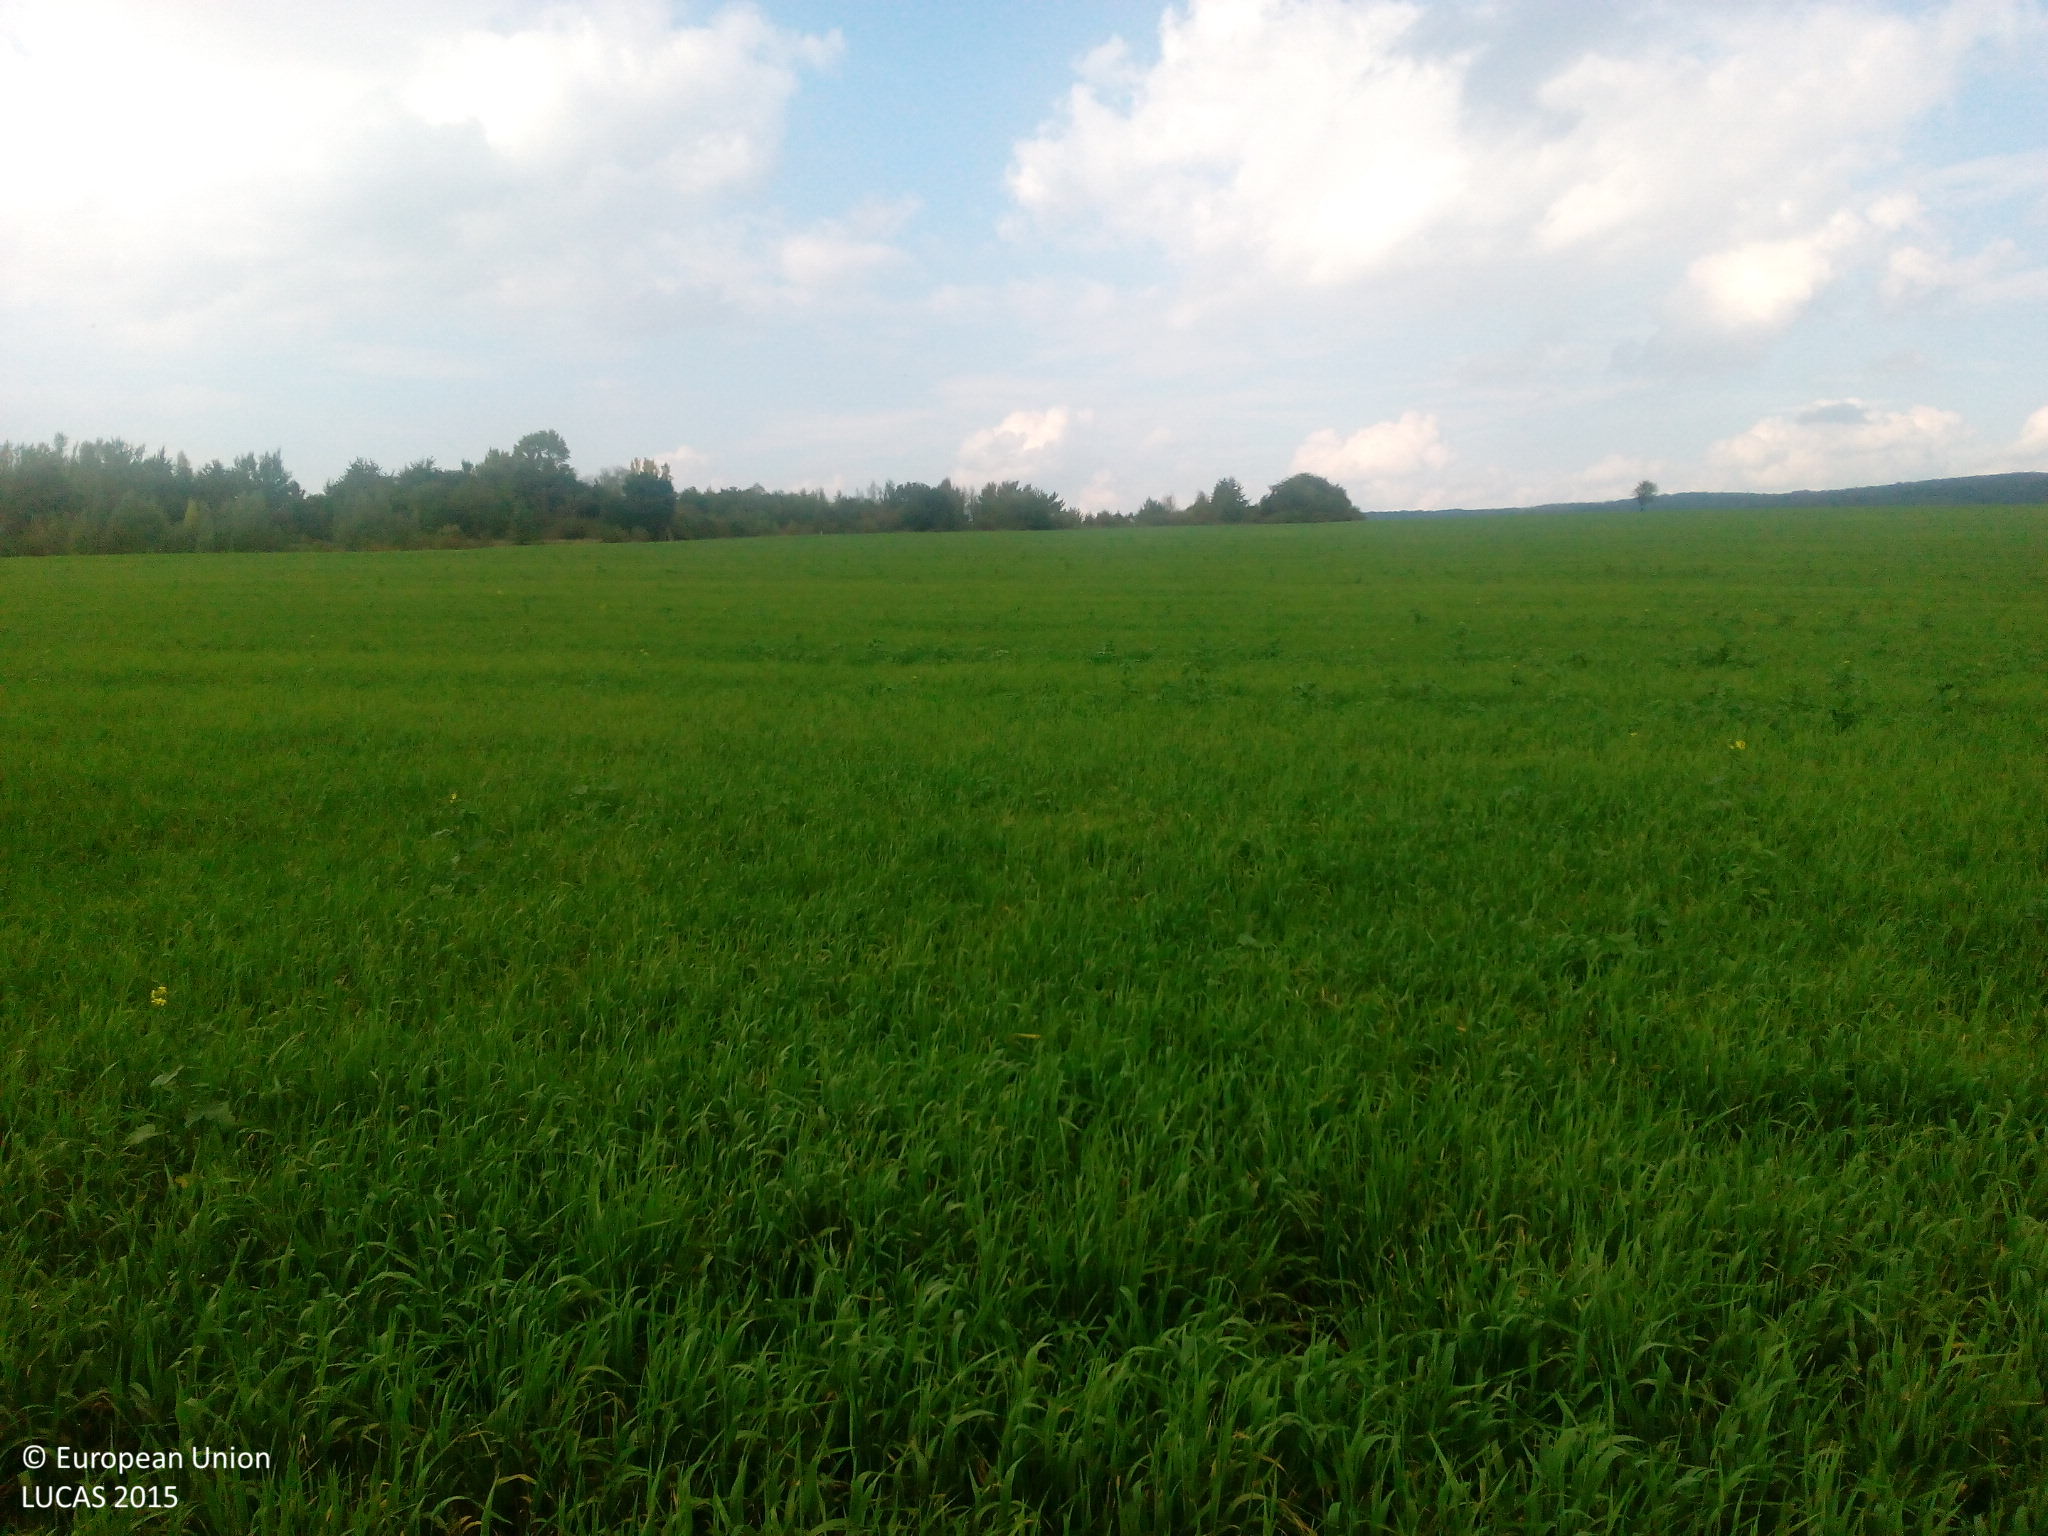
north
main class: Cropland
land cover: Temporary grasslands
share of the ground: > 75 %
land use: Agriculture (excluding fallow land and kitchen gardens)
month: September
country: DE
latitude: 51.3844
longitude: 11.0199
